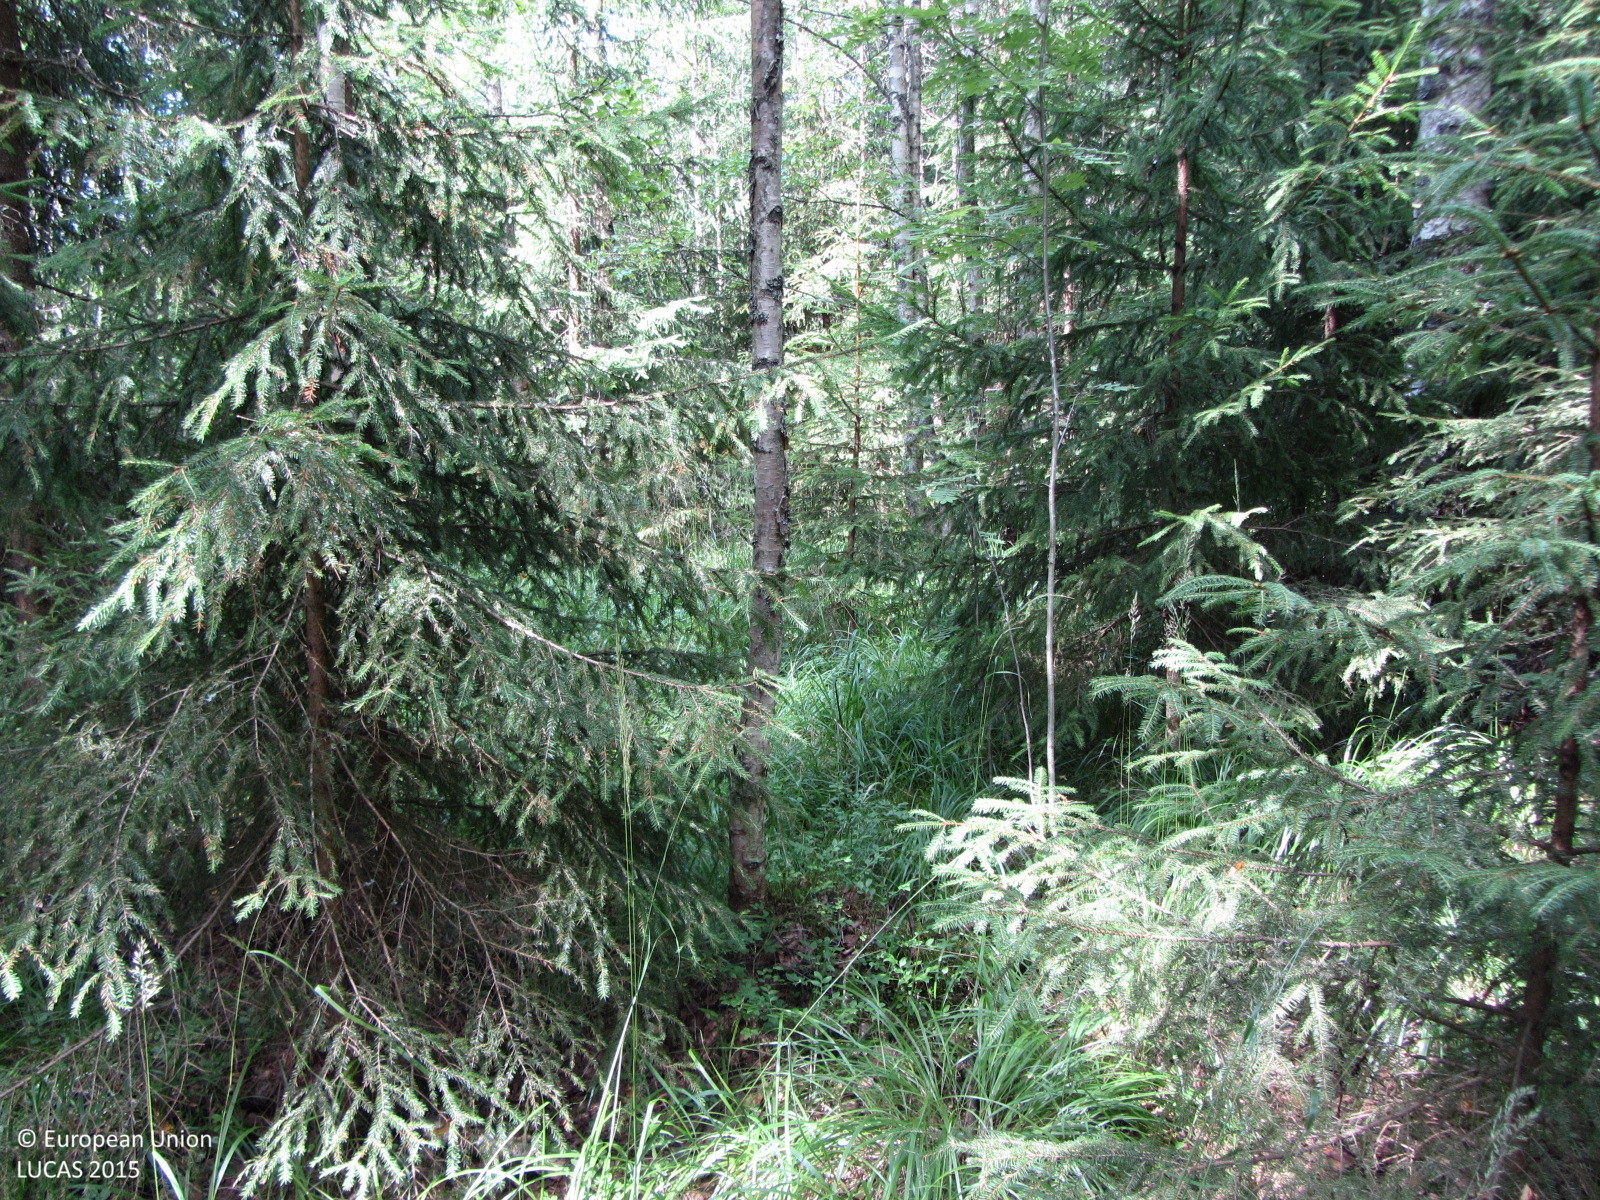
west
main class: Woodland
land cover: Spruce dominated mixed woodland
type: boreal forest
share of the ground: > 75 %
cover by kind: coniferous forest trees 45 %, broadleaved forest trees 45 %, herbaceous plants 10 %
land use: Forestry
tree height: > 5 m
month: July
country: FI
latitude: 60.6099
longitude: 24.4069
